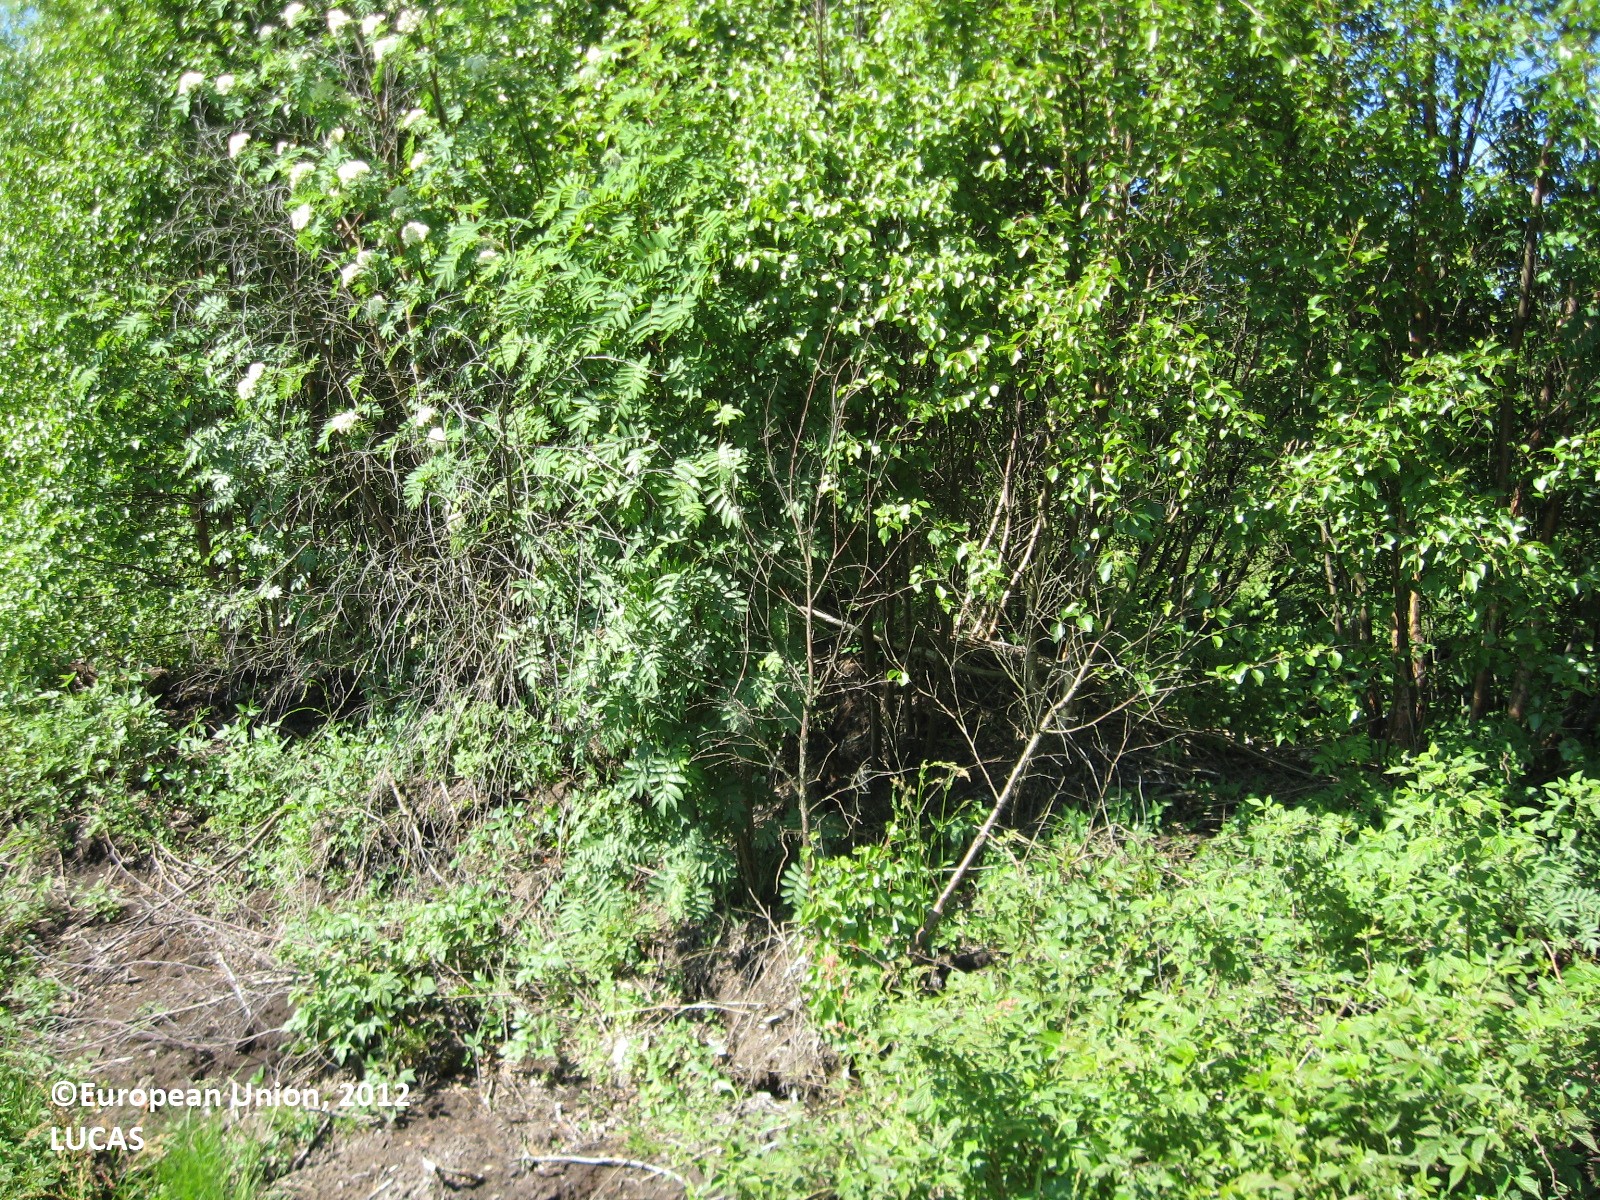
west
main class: Cropland
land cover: Oats
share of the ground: > 75 %
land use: Agriculture (excluding fallow land and kitchen gardens)
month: June
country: FI
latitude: 62.9441
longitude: 21.6484
